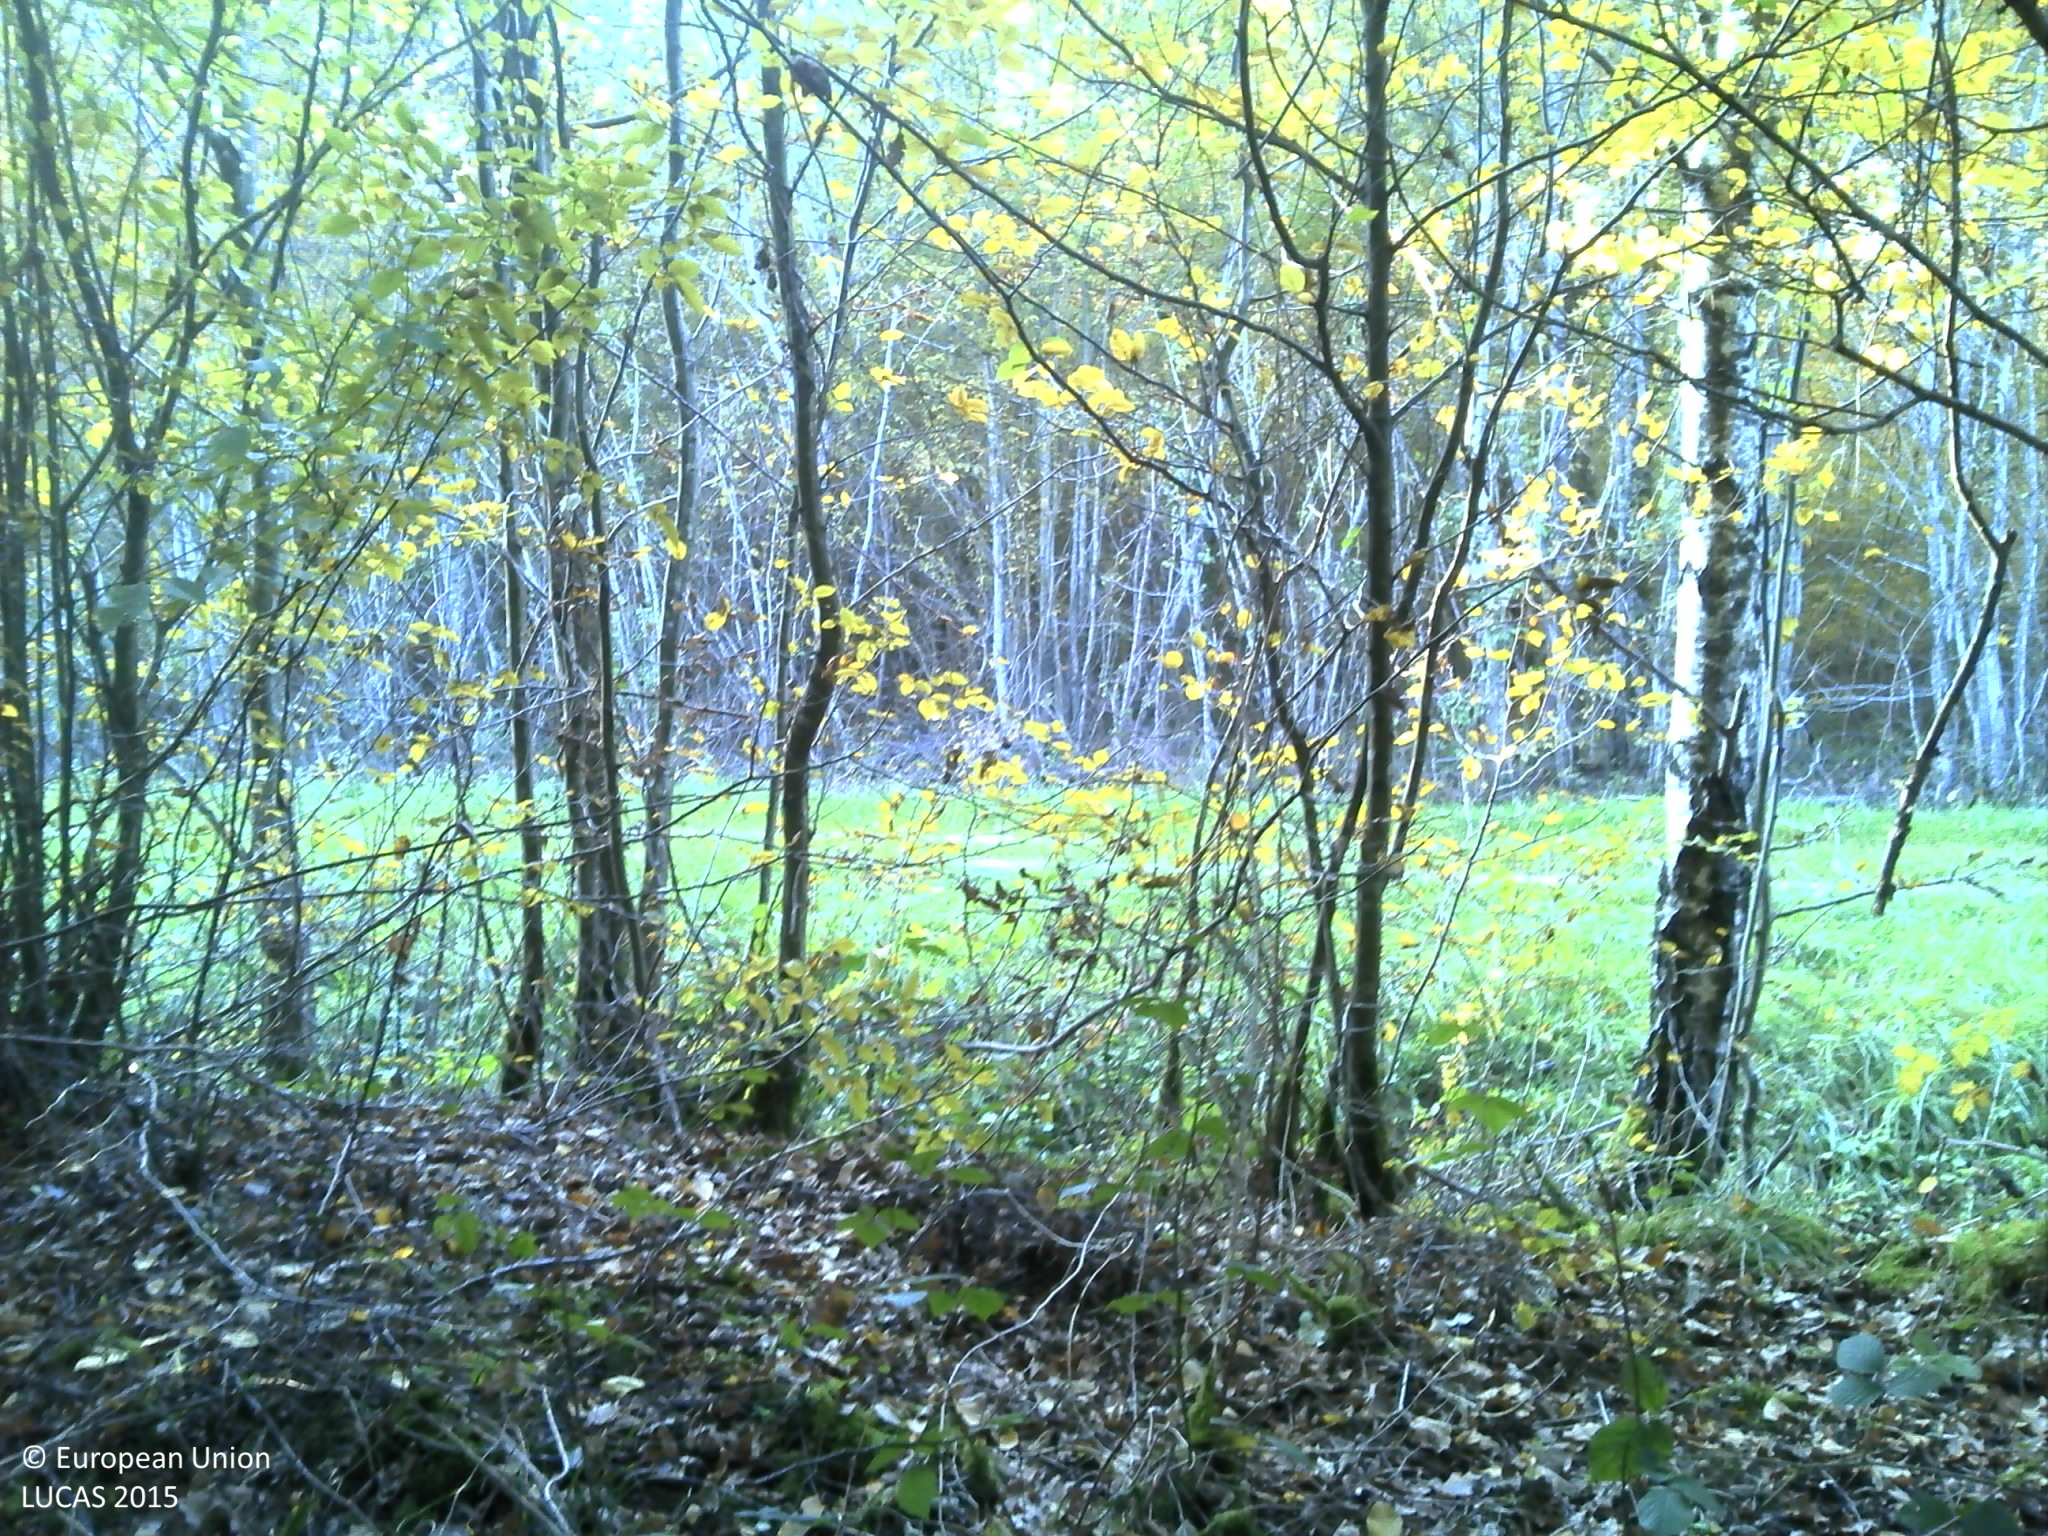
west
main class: Woodland
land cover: Broadleaved woodland
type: mesophytic deciduous forest
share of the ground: > 75 %
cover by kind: broadleaved forest trees 100 %
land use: Forestry
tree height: > 5 m
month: October
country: FR
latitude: 47.1877
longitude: 5.3425
